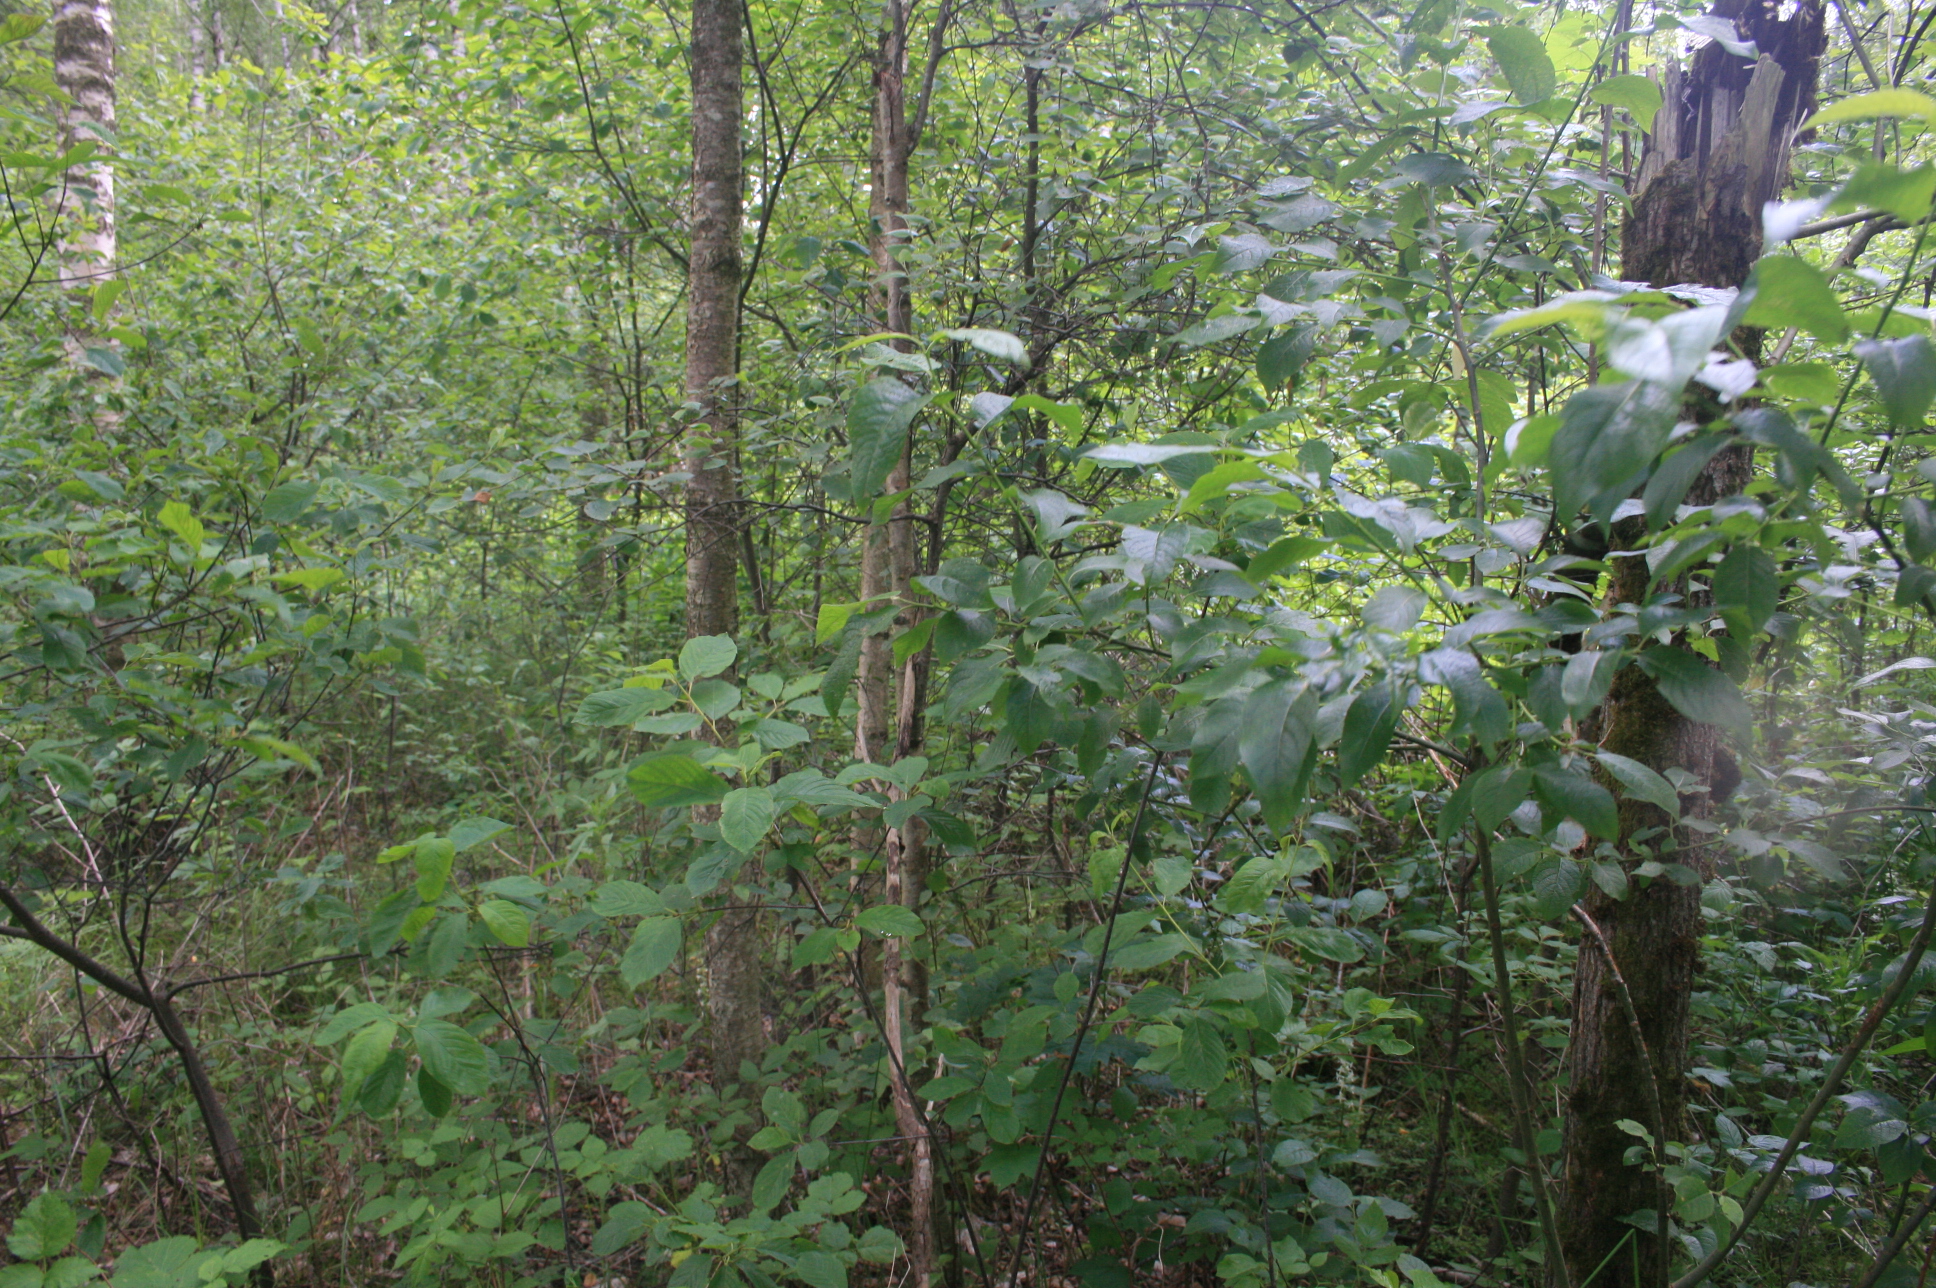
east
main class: Woodland
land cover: Broadleaved woodland
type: non-riverine alder, birch or aspen forest
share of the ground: > 75 %
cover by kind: broadleaved forest trees 90 %, herbaceous plants 10 %
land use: Forestry
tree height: > 5 m
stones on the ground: < 10 %
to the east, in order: Broadleaved woodland; Spontaneously vegetated surfaces; Paved roads, cycling and walking lanes; Spontaneously vegetated surfaces; Broadleaved woodland
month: June
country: LT
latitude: 55.3324
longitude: 21.7945
